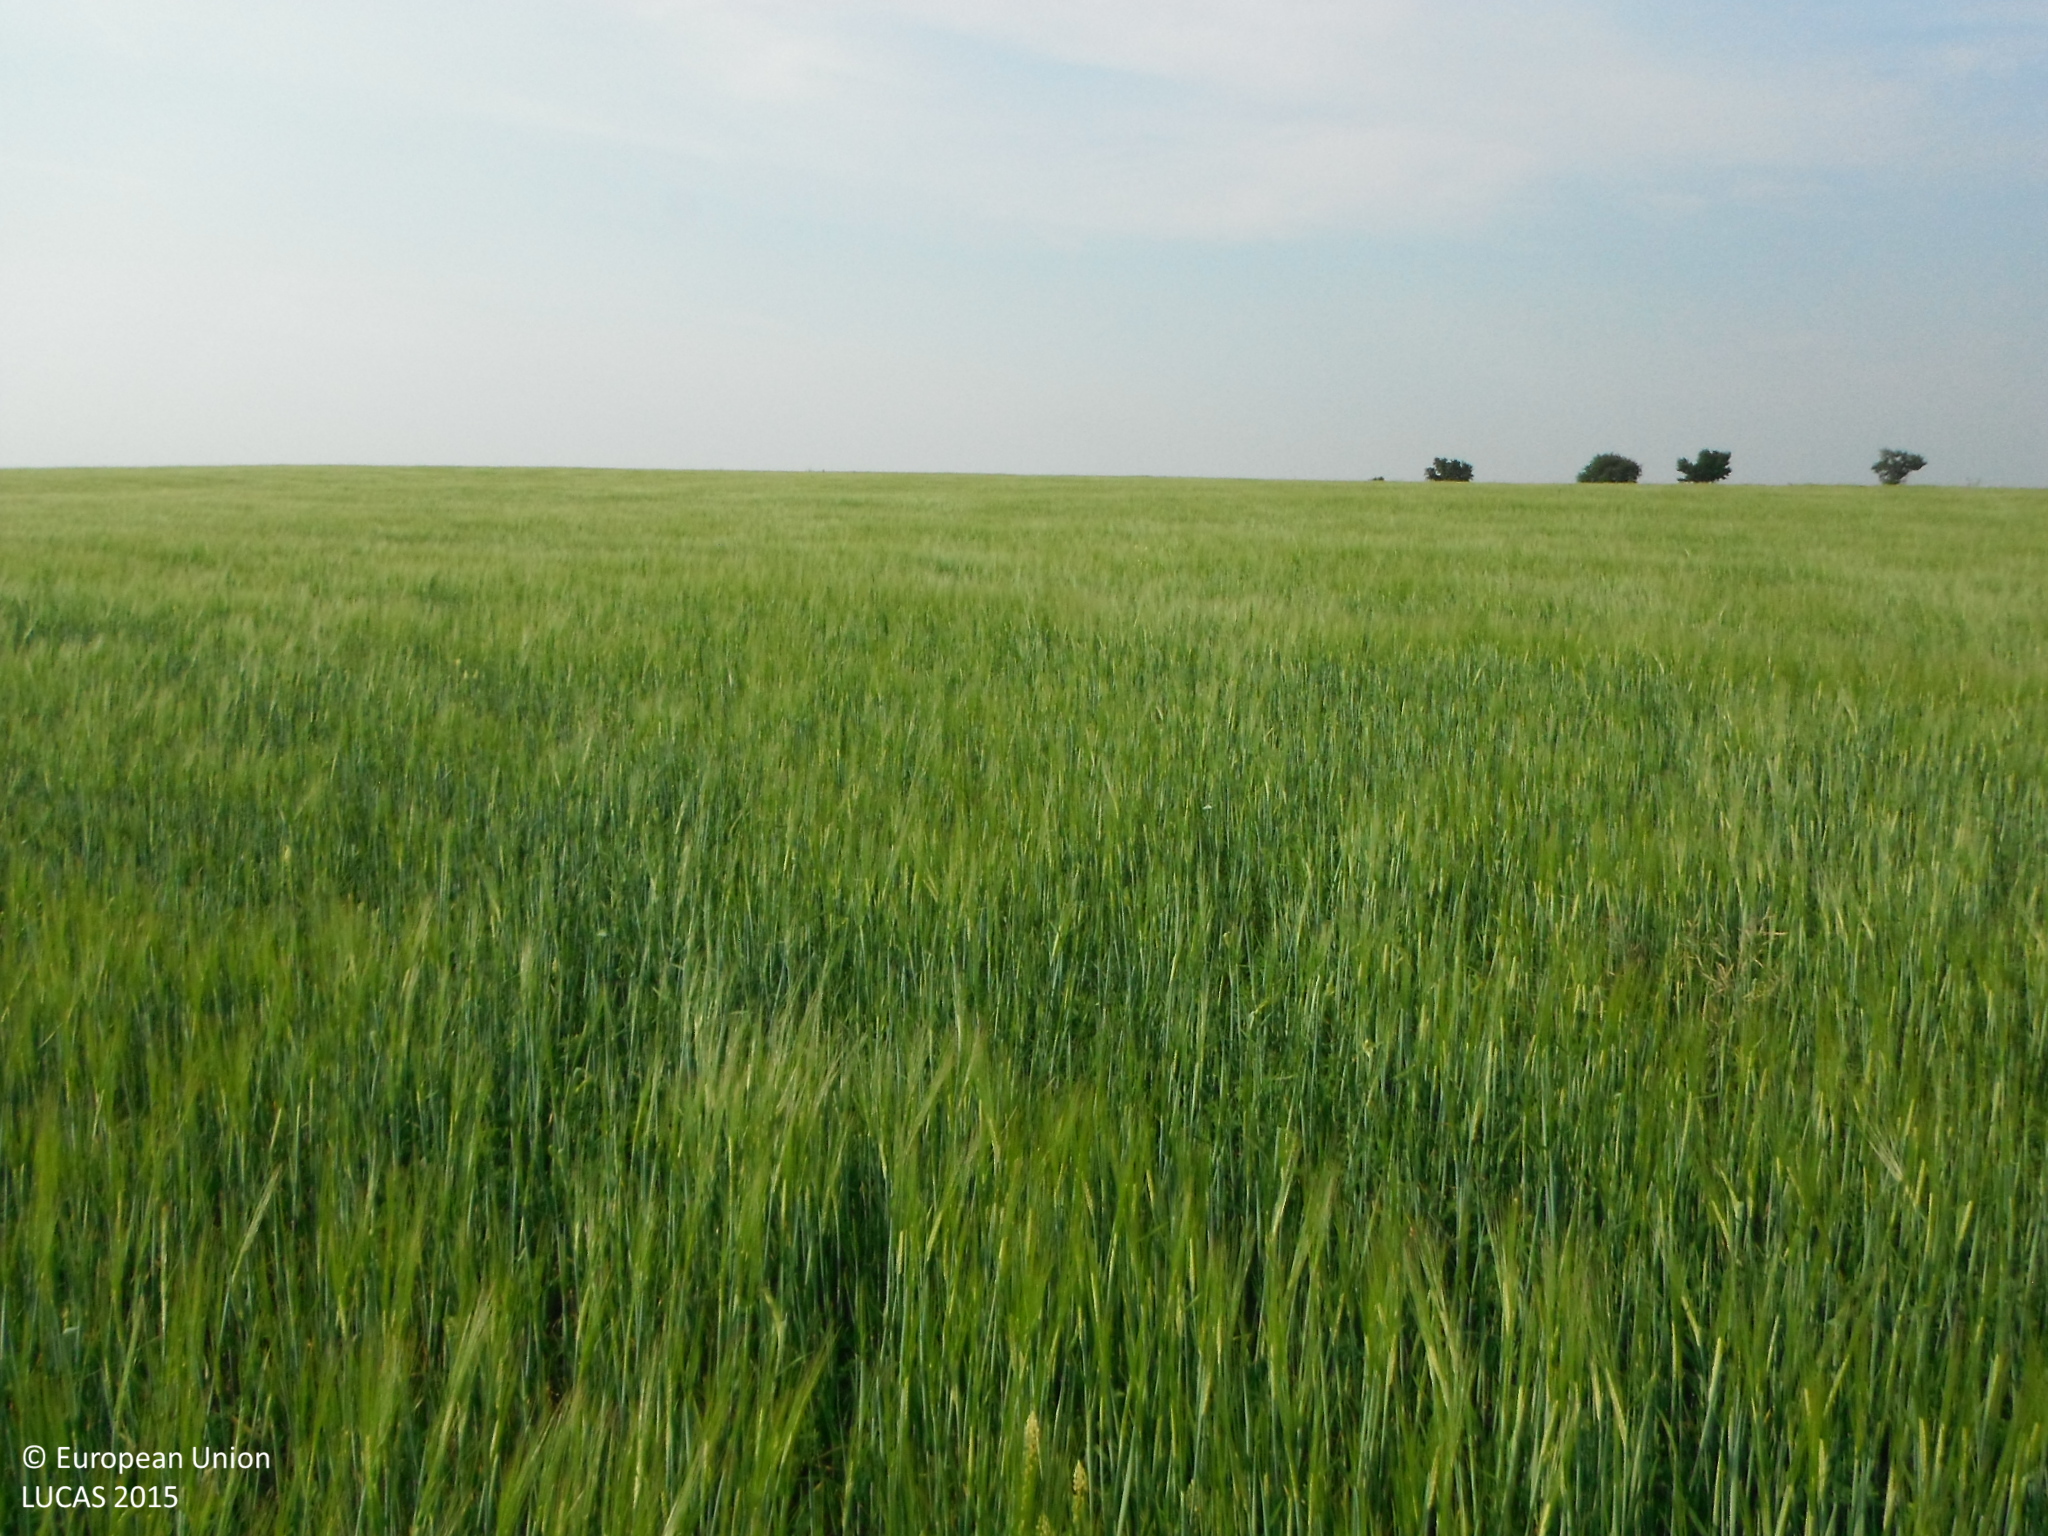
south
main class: Cropland
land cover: Barley
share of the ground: > 75 %
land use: Agriculture (excluding fallow land and kitchen gardens)
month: June
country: SK
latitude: 48.3653
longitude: 17.5018
